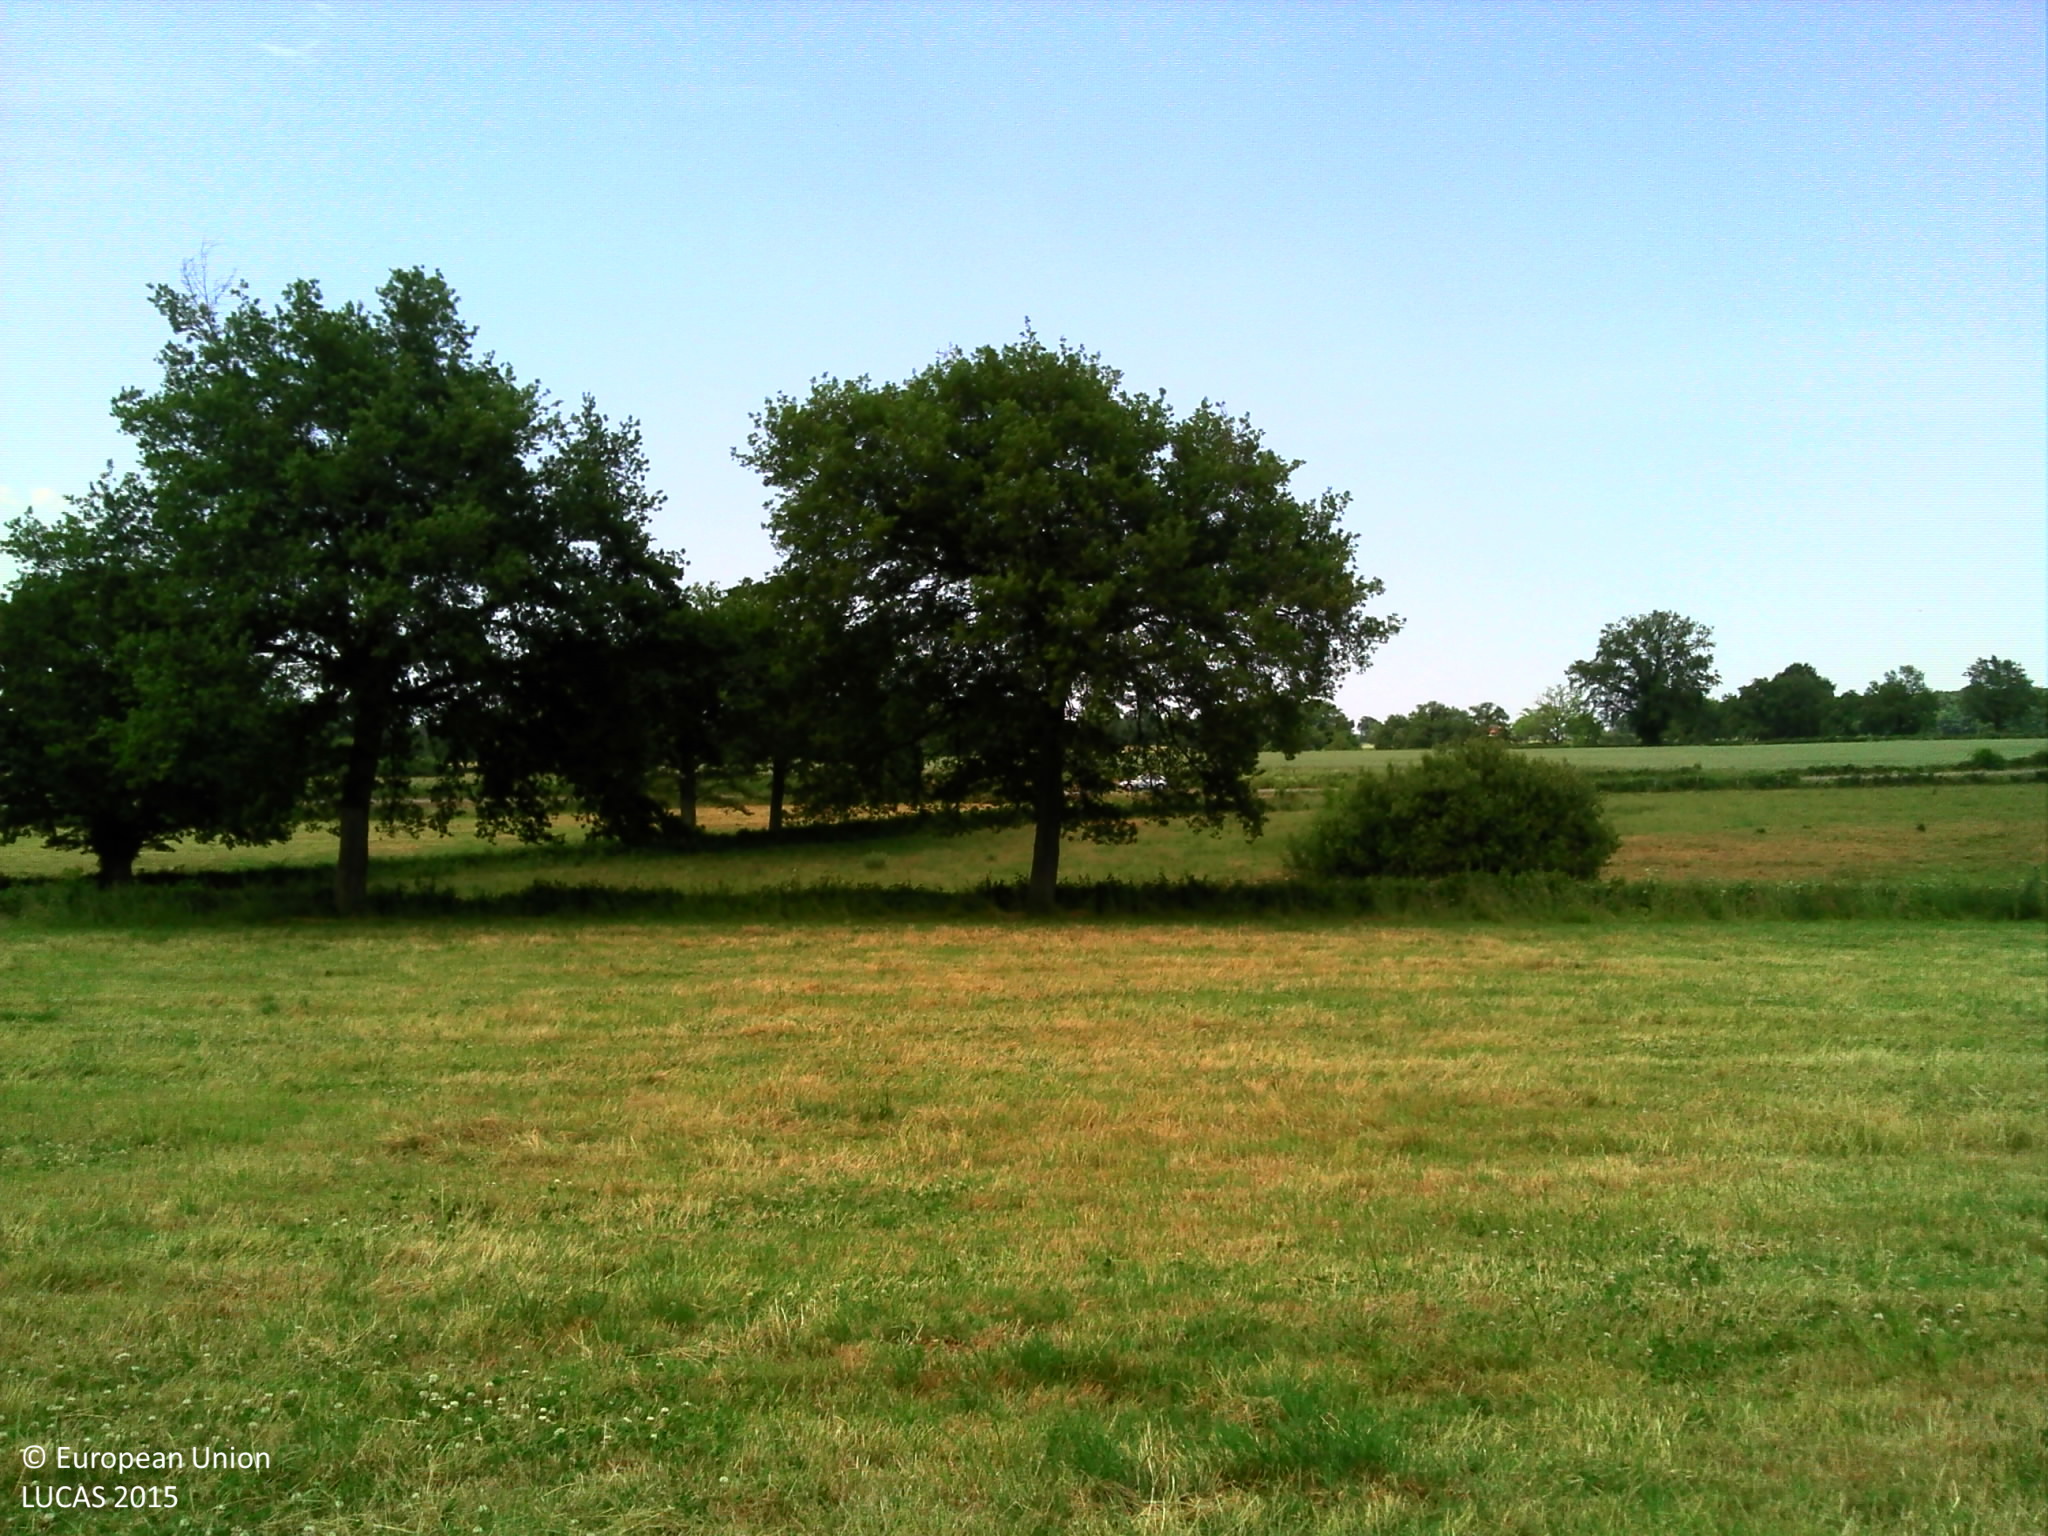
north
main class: Cropland
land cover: Temporary grasslands
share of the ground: > 75 %
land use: Agriculture (excluding fallow land and kitchen gardens)
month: June
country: FR
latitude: 46.3204
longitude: 2.9974
